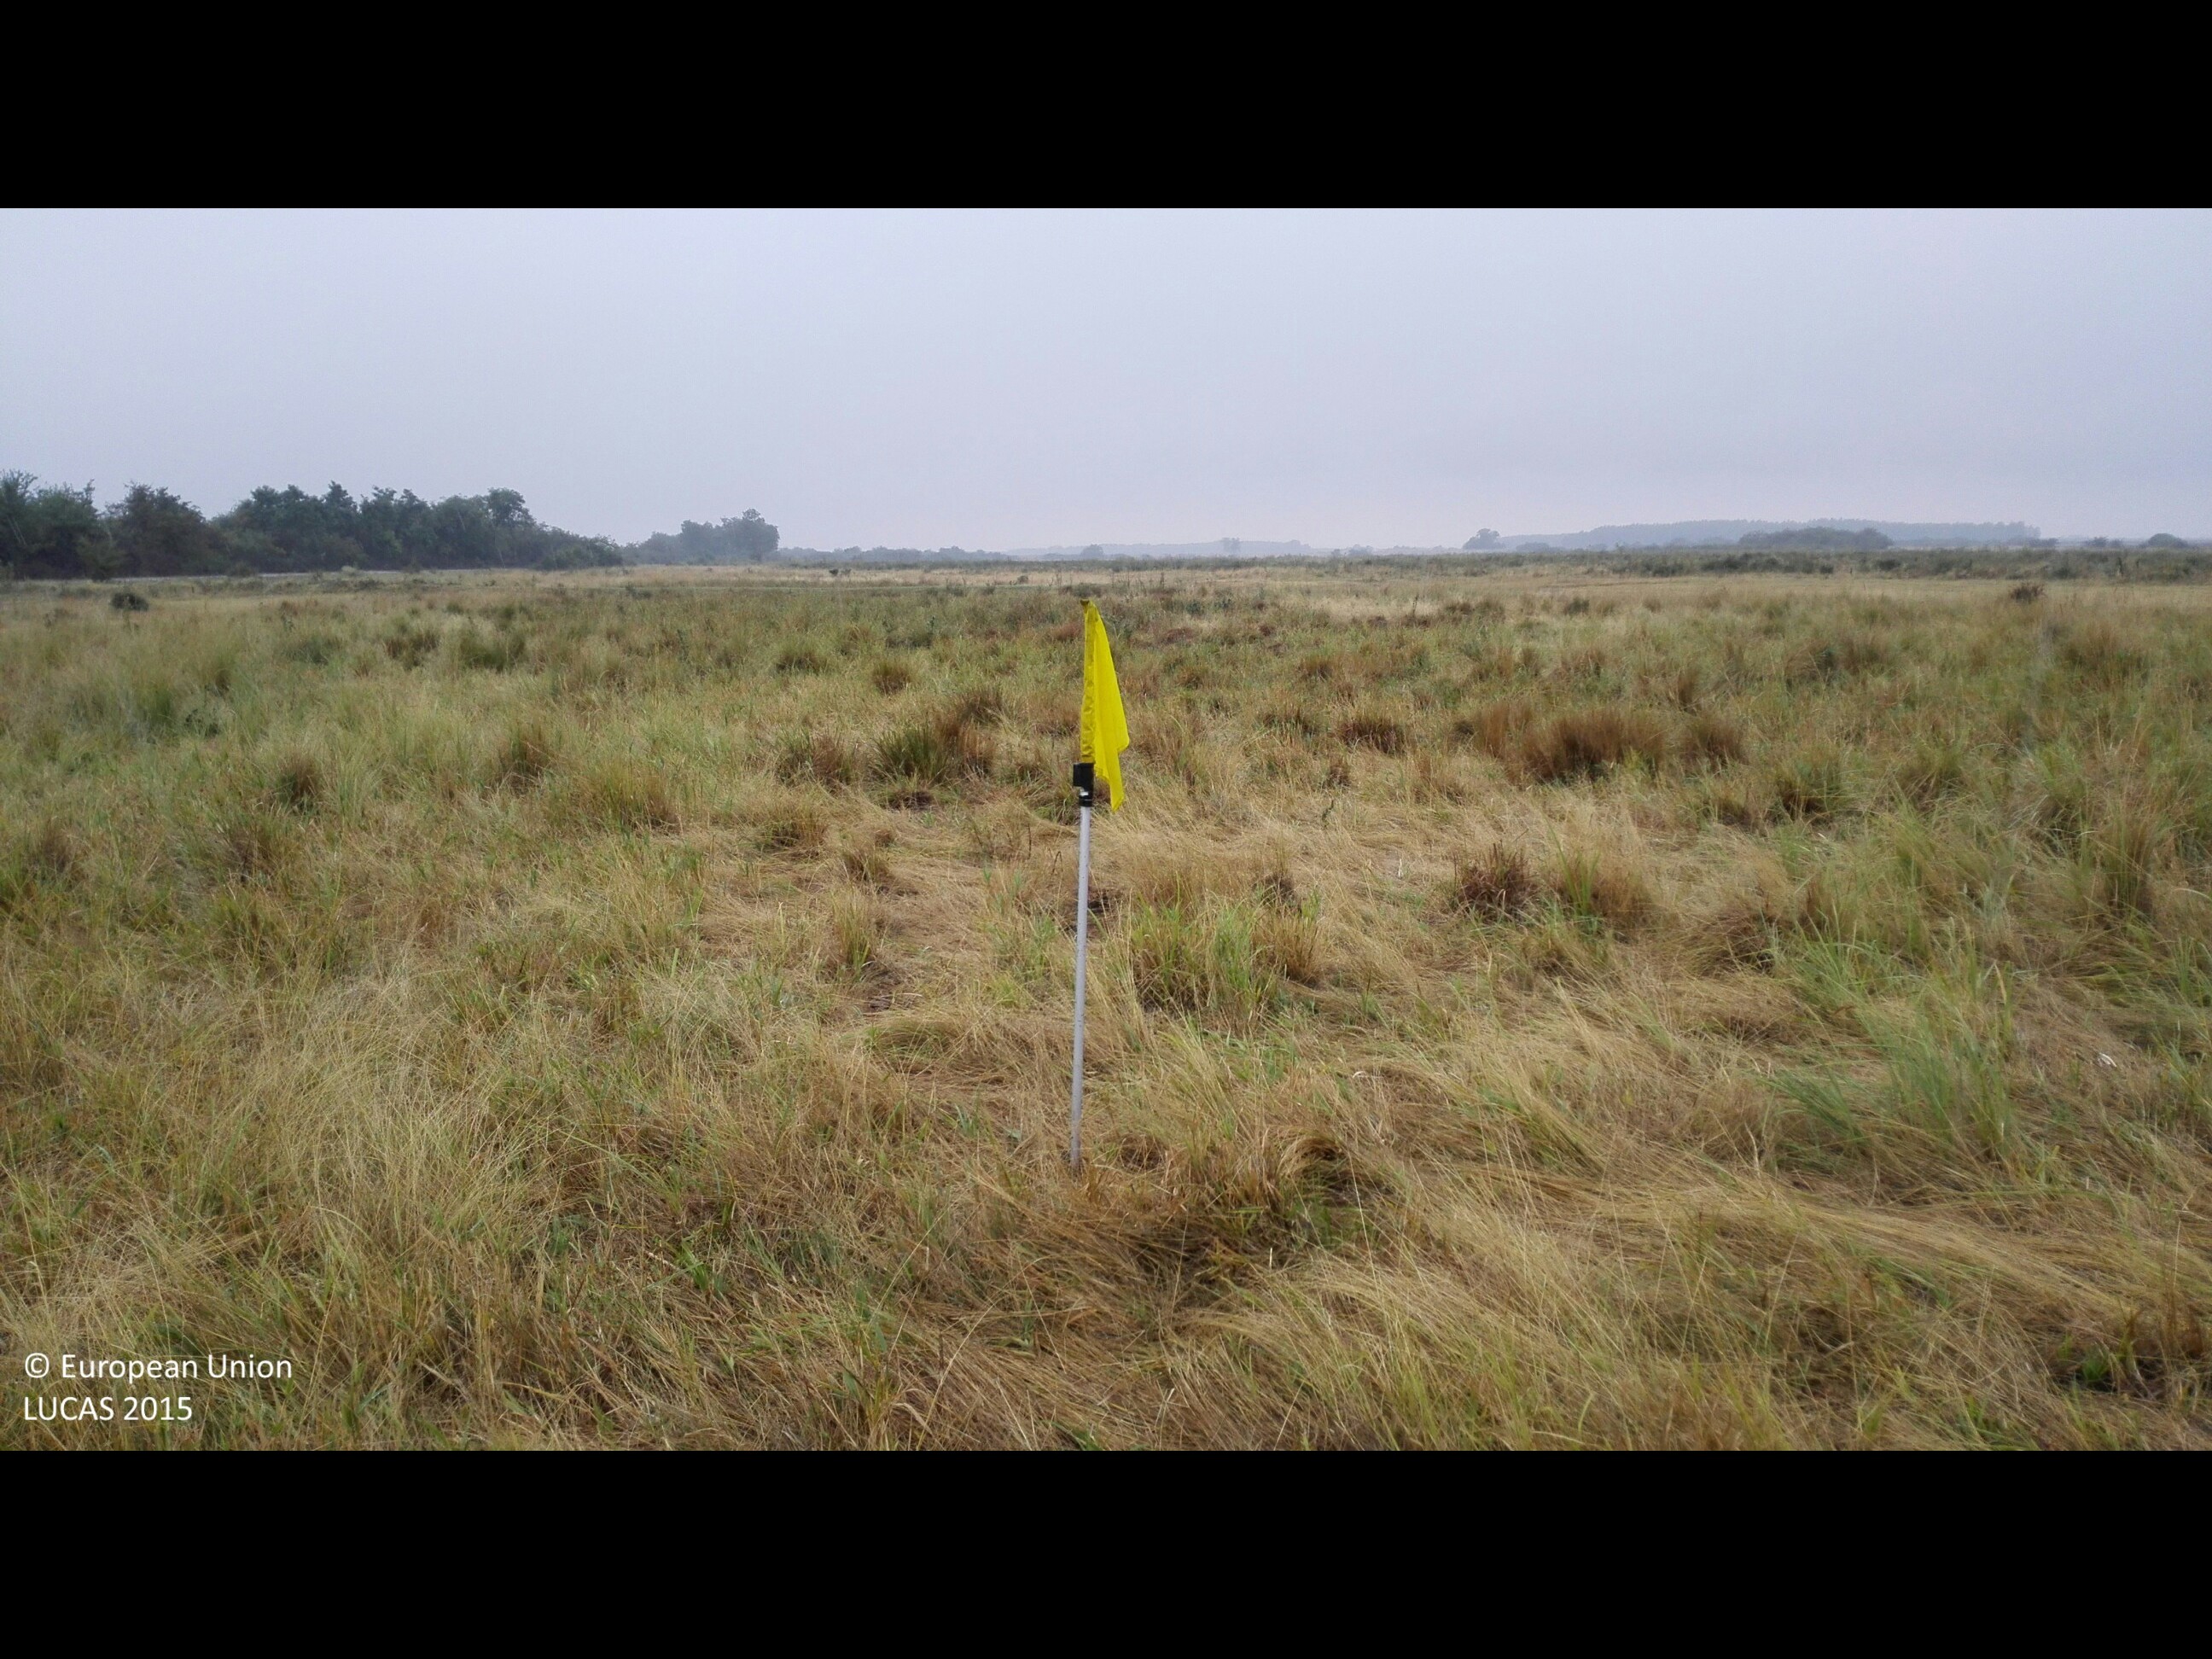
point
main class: Grassland
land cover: Grassland without tree/shrub cover
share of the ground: > 75 %
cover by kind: herbaceous plants 100 %
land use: Agriculture (excluding fallow land and kitchen gardens)
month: August
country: HU
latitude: 47.2697
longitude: 21.8765
